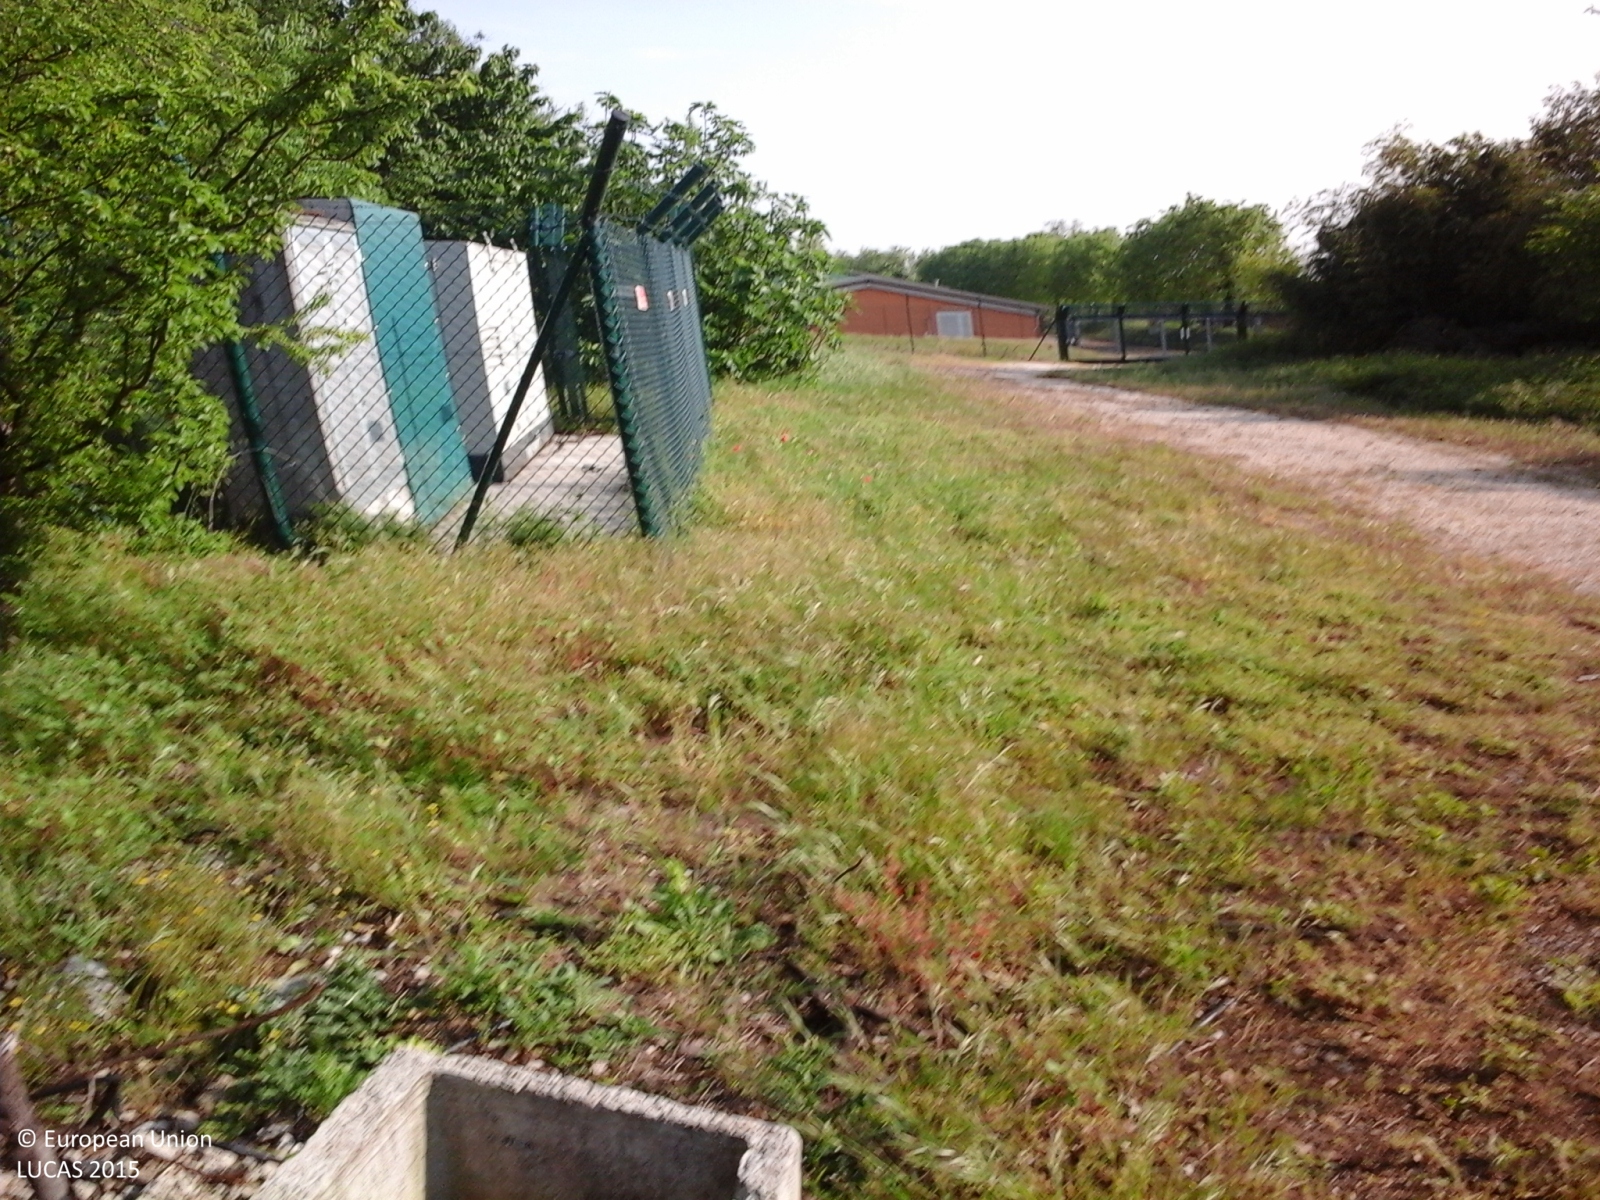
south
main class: Woodland
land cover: Broadleaved woodland
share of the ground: > 75 %
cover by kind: broadleaved forest trees 90 %, consolidated bare surface 10 %
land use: Residential
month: April
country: IT
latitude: 45.3955
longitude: 10.3953
